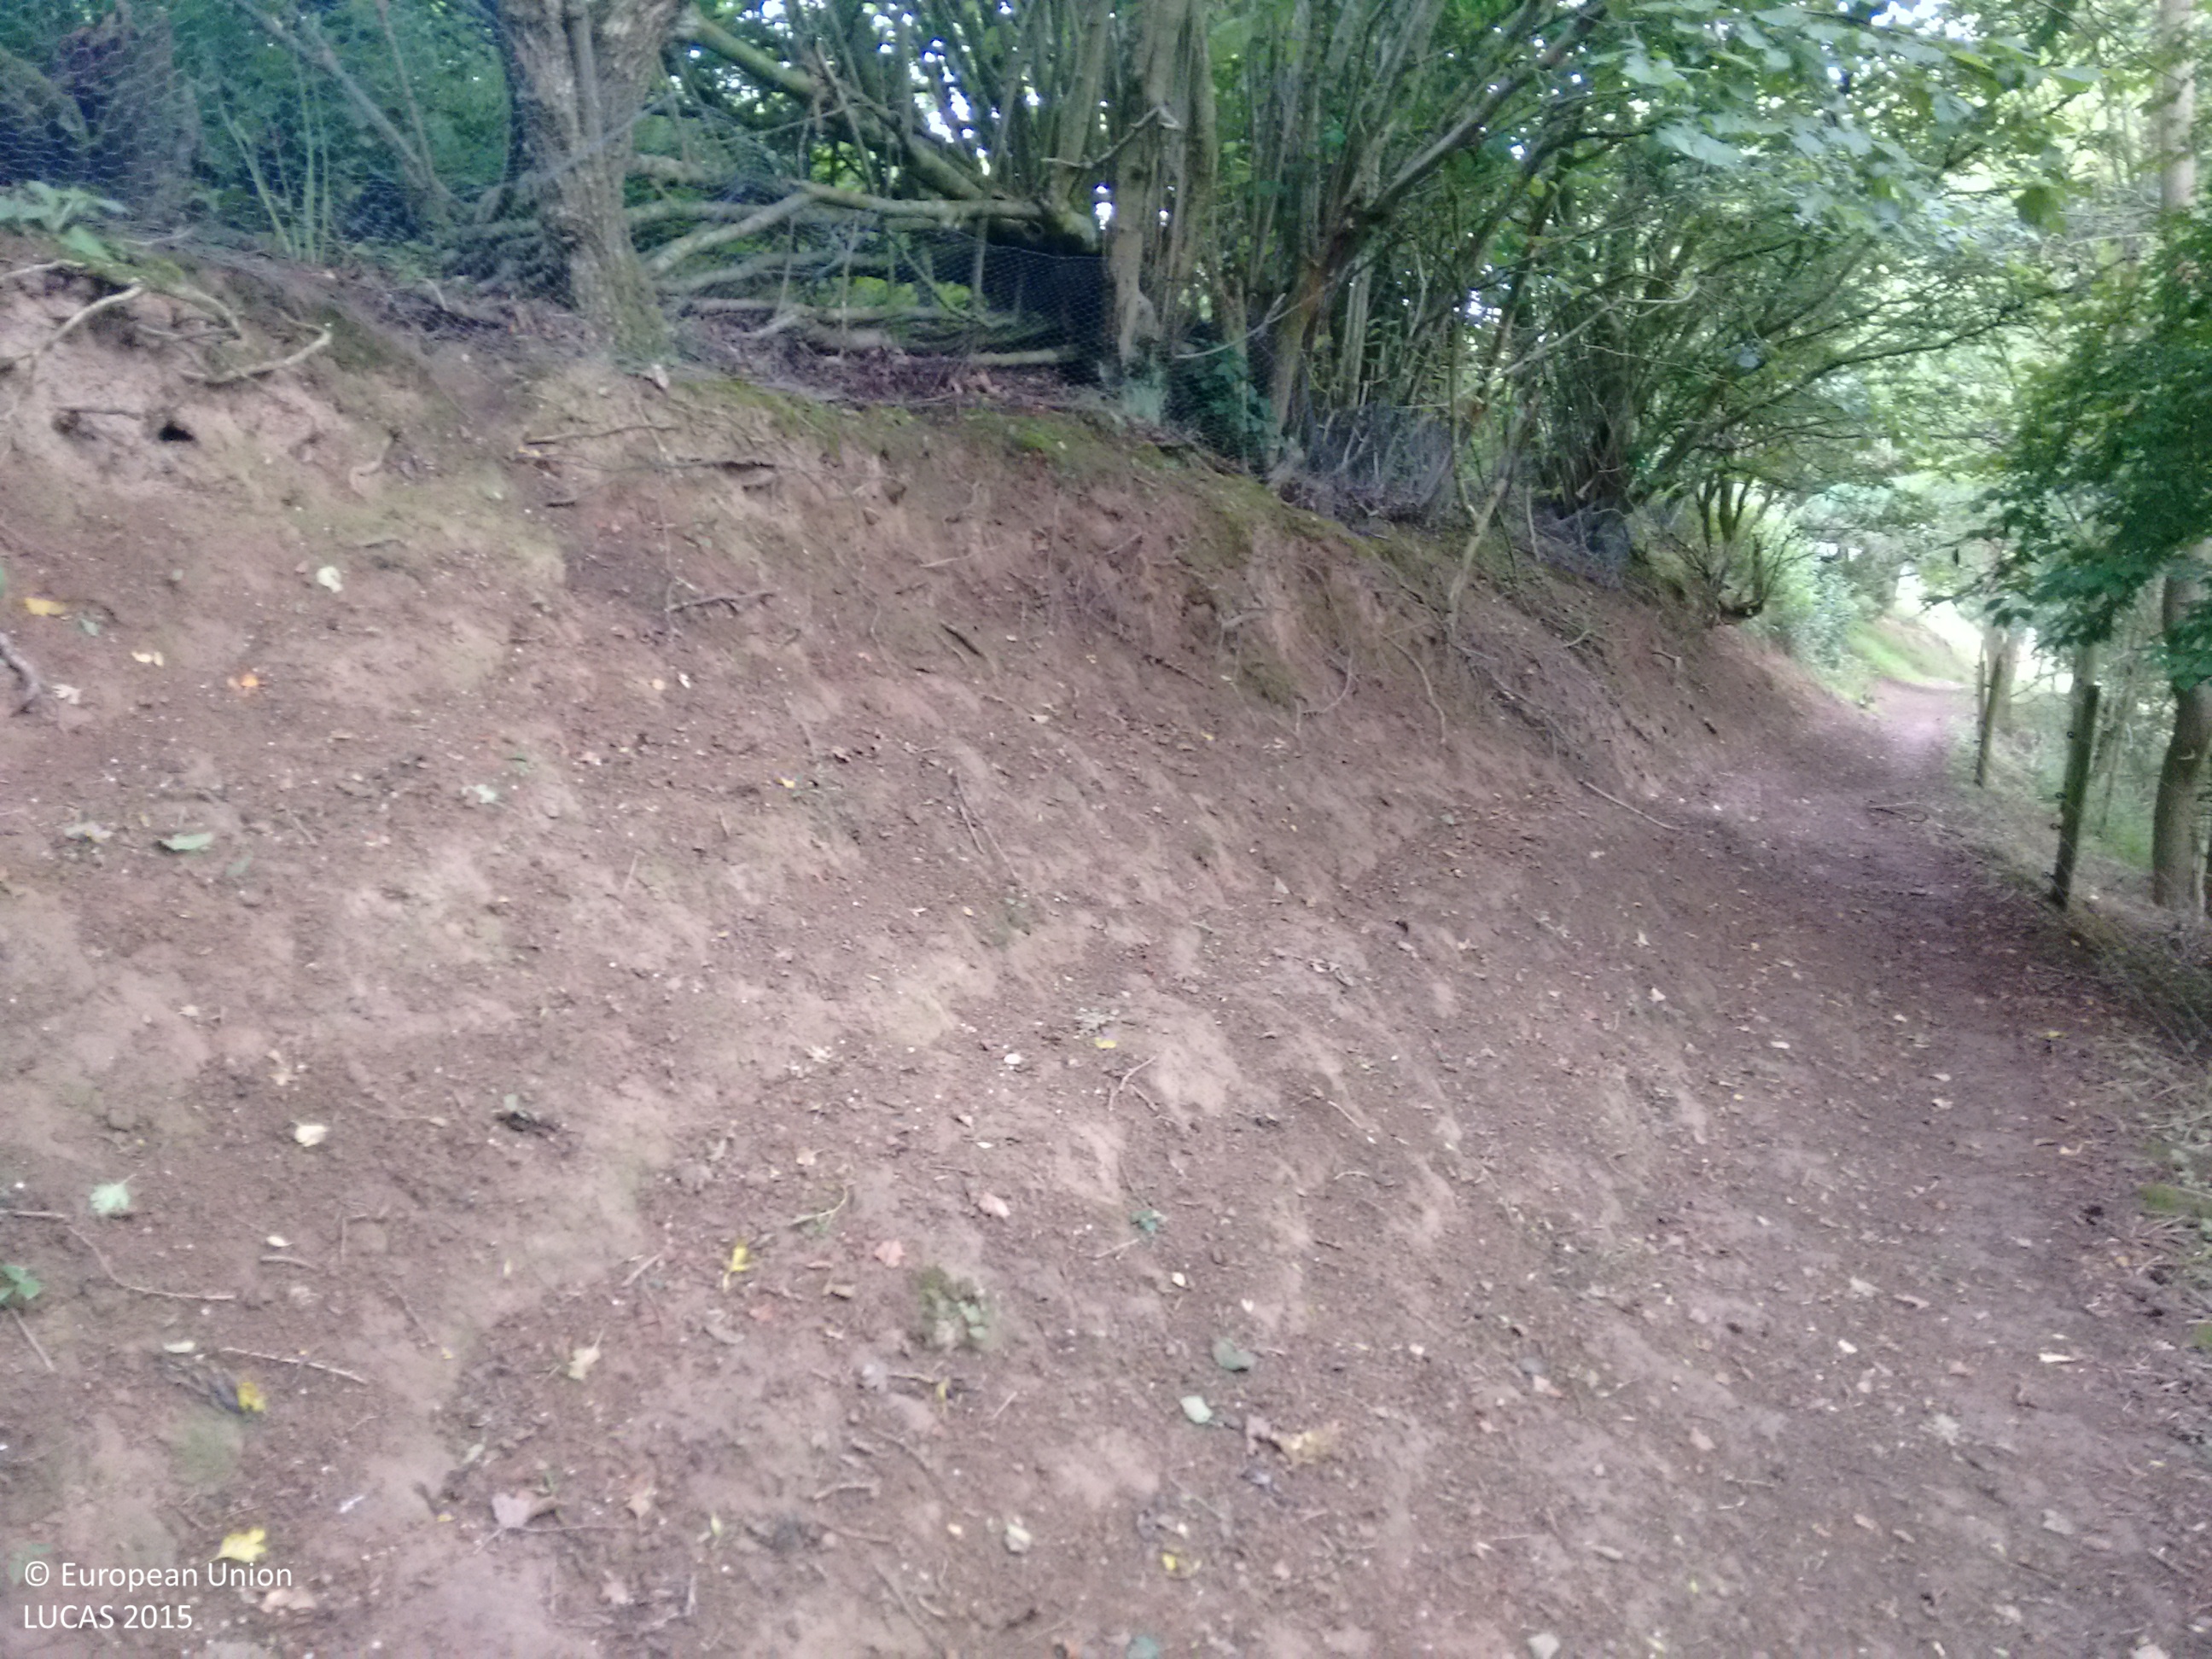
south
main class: Woodland
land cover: Other mixed woodland
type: mesophytic deciduous forest
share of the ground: > 75 %
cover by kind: broadleaved forest trees 55 %, coniferous forest trees 40 %, shrubs 5 %
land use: Semi-natural and natural areas not in use
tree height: > 5 m
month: July
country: GB
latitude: 52.3836
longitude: -2.8694
